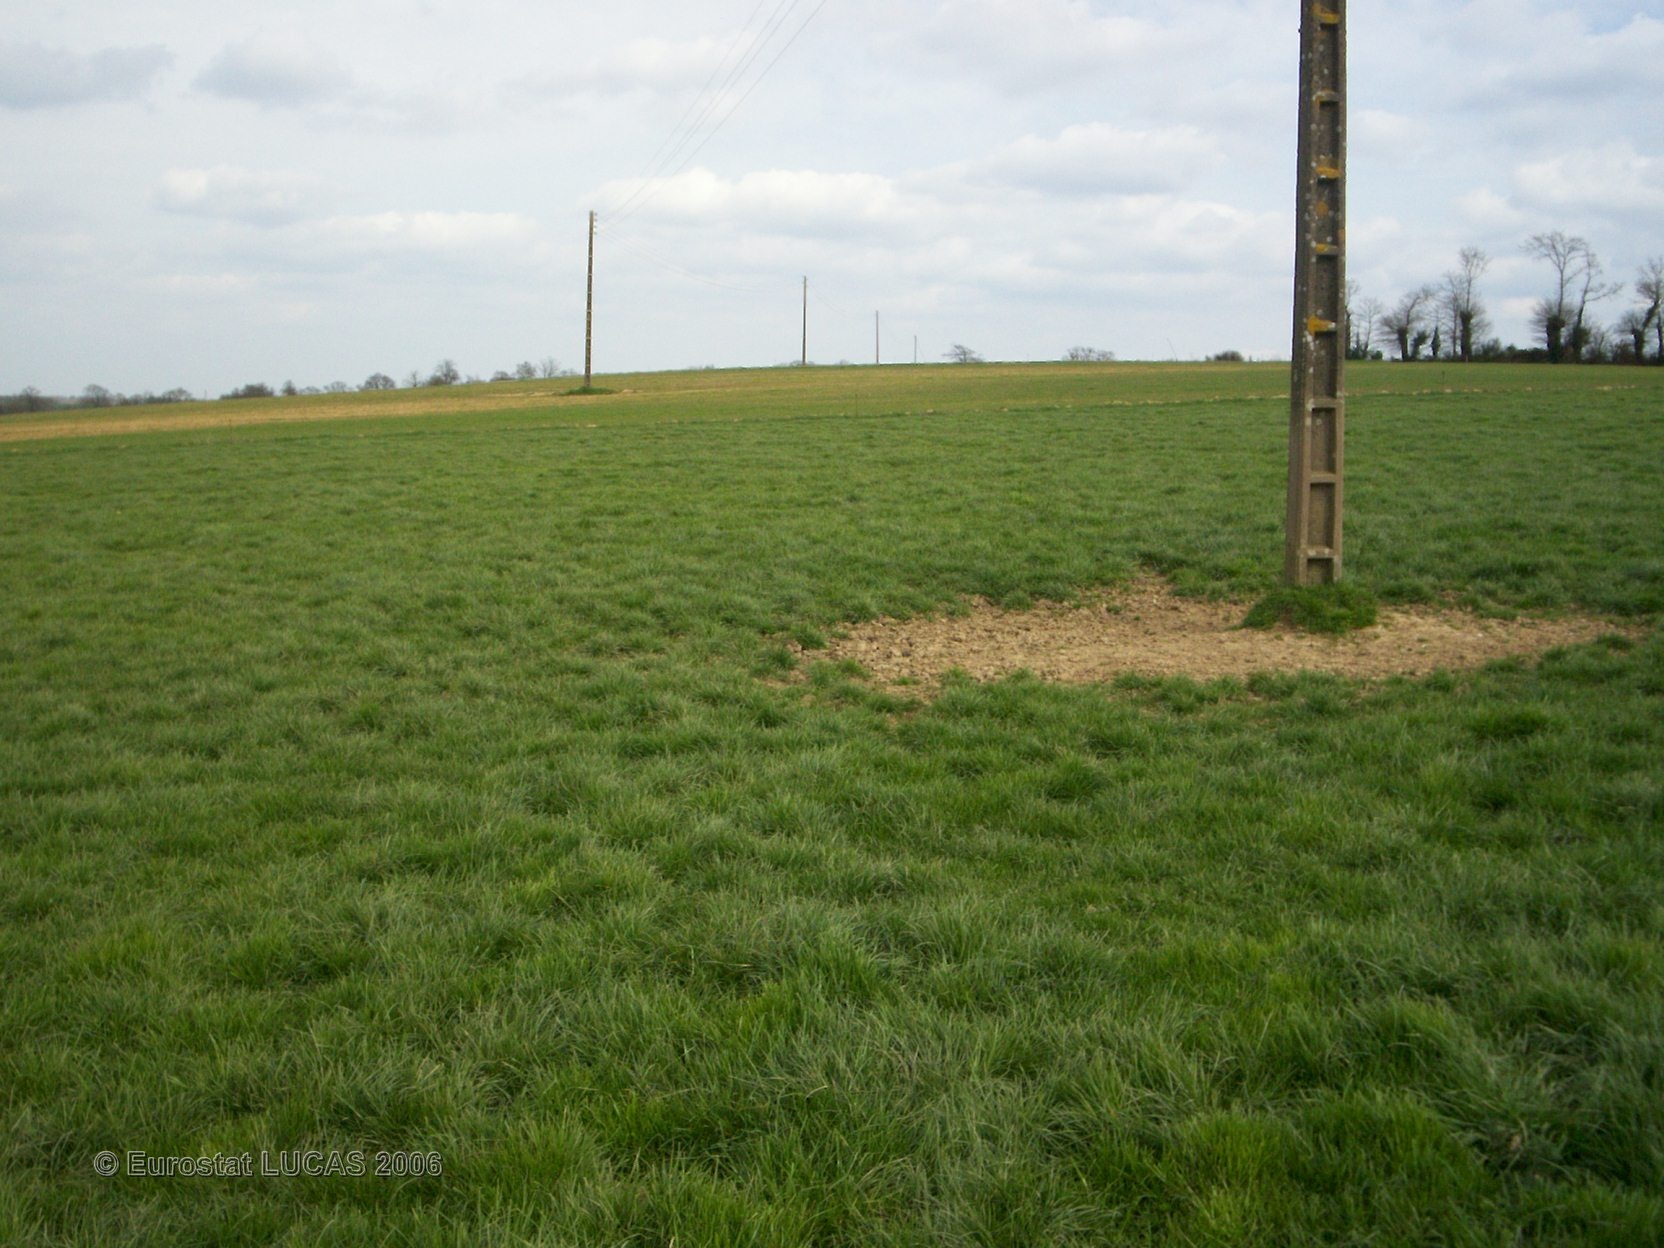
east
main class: Grassland
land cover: Grassland without tree/shrub cover
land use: Agriculture (excluding fallow land and kitchen gardens)
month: April
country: FR
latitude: 47.9390
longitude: -1.5719
